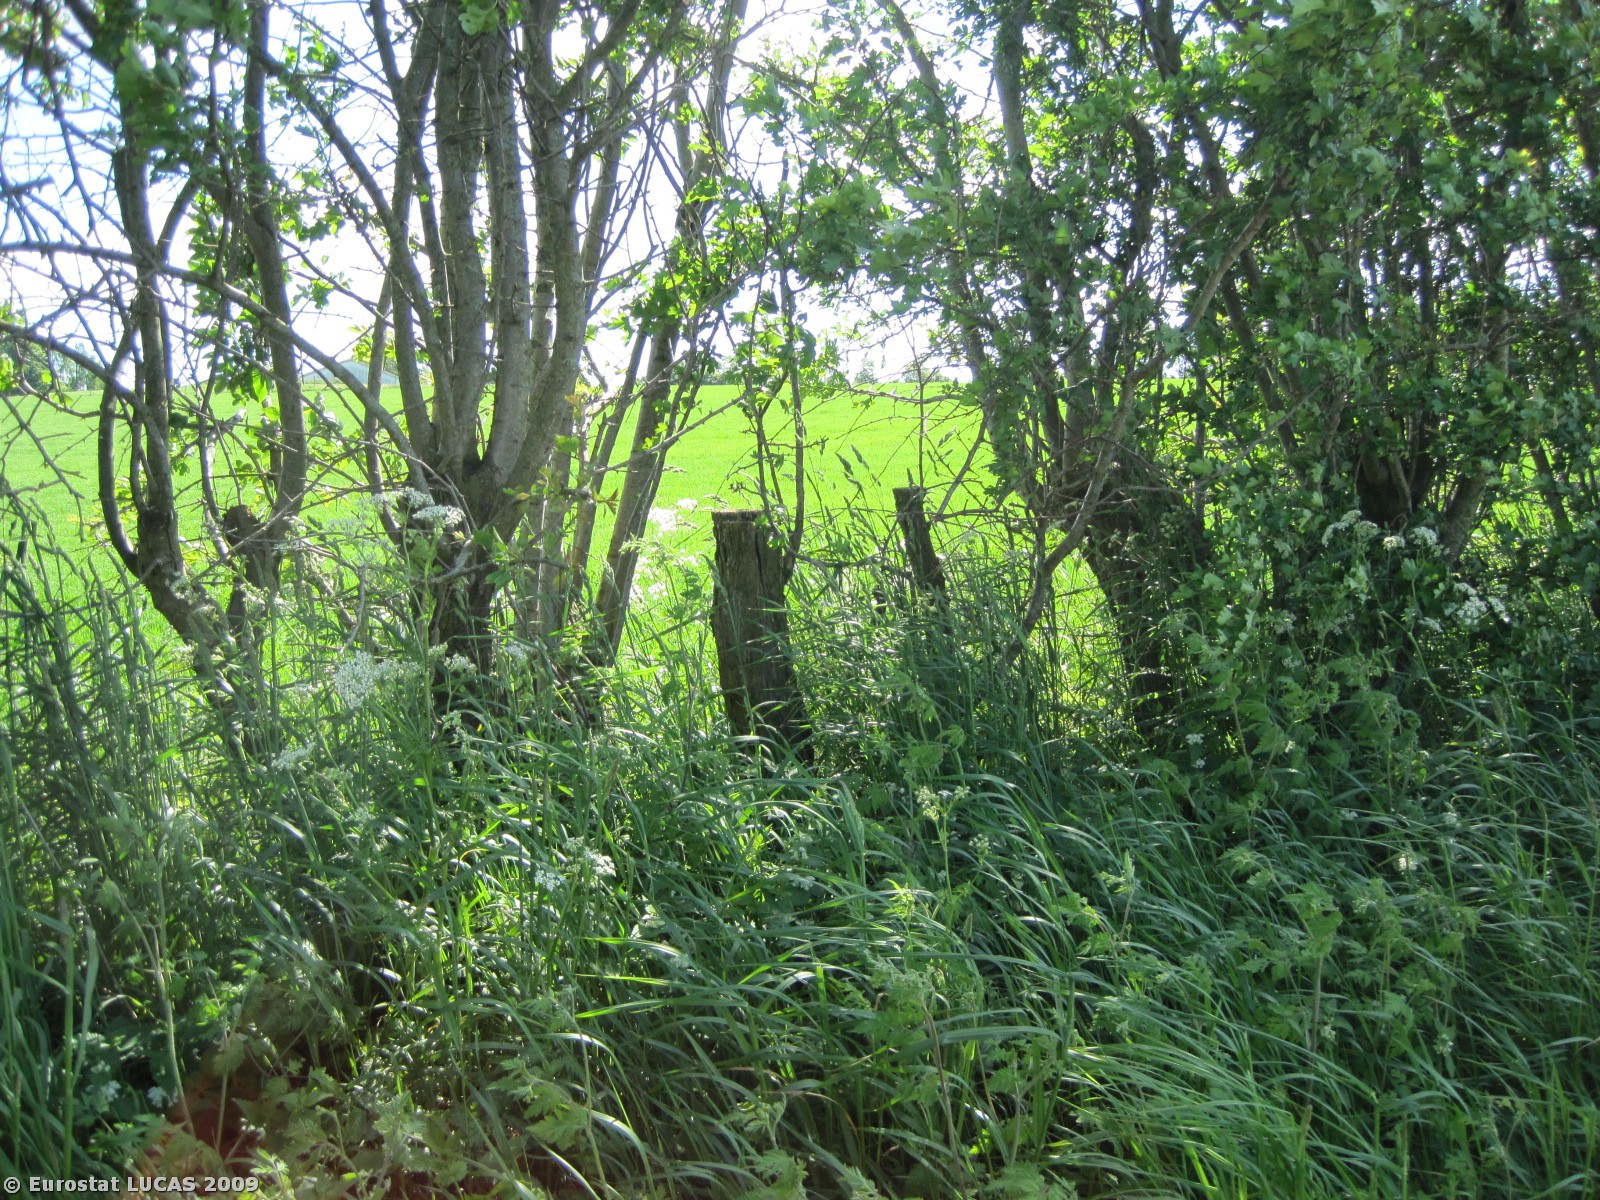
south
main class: Cropland
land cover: Maize
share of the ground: 10 - 25 %
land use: Agriculture (excluding fallow land and kitchen gardens)
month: May
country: DK
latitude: 56.8349
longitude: 10.0491
